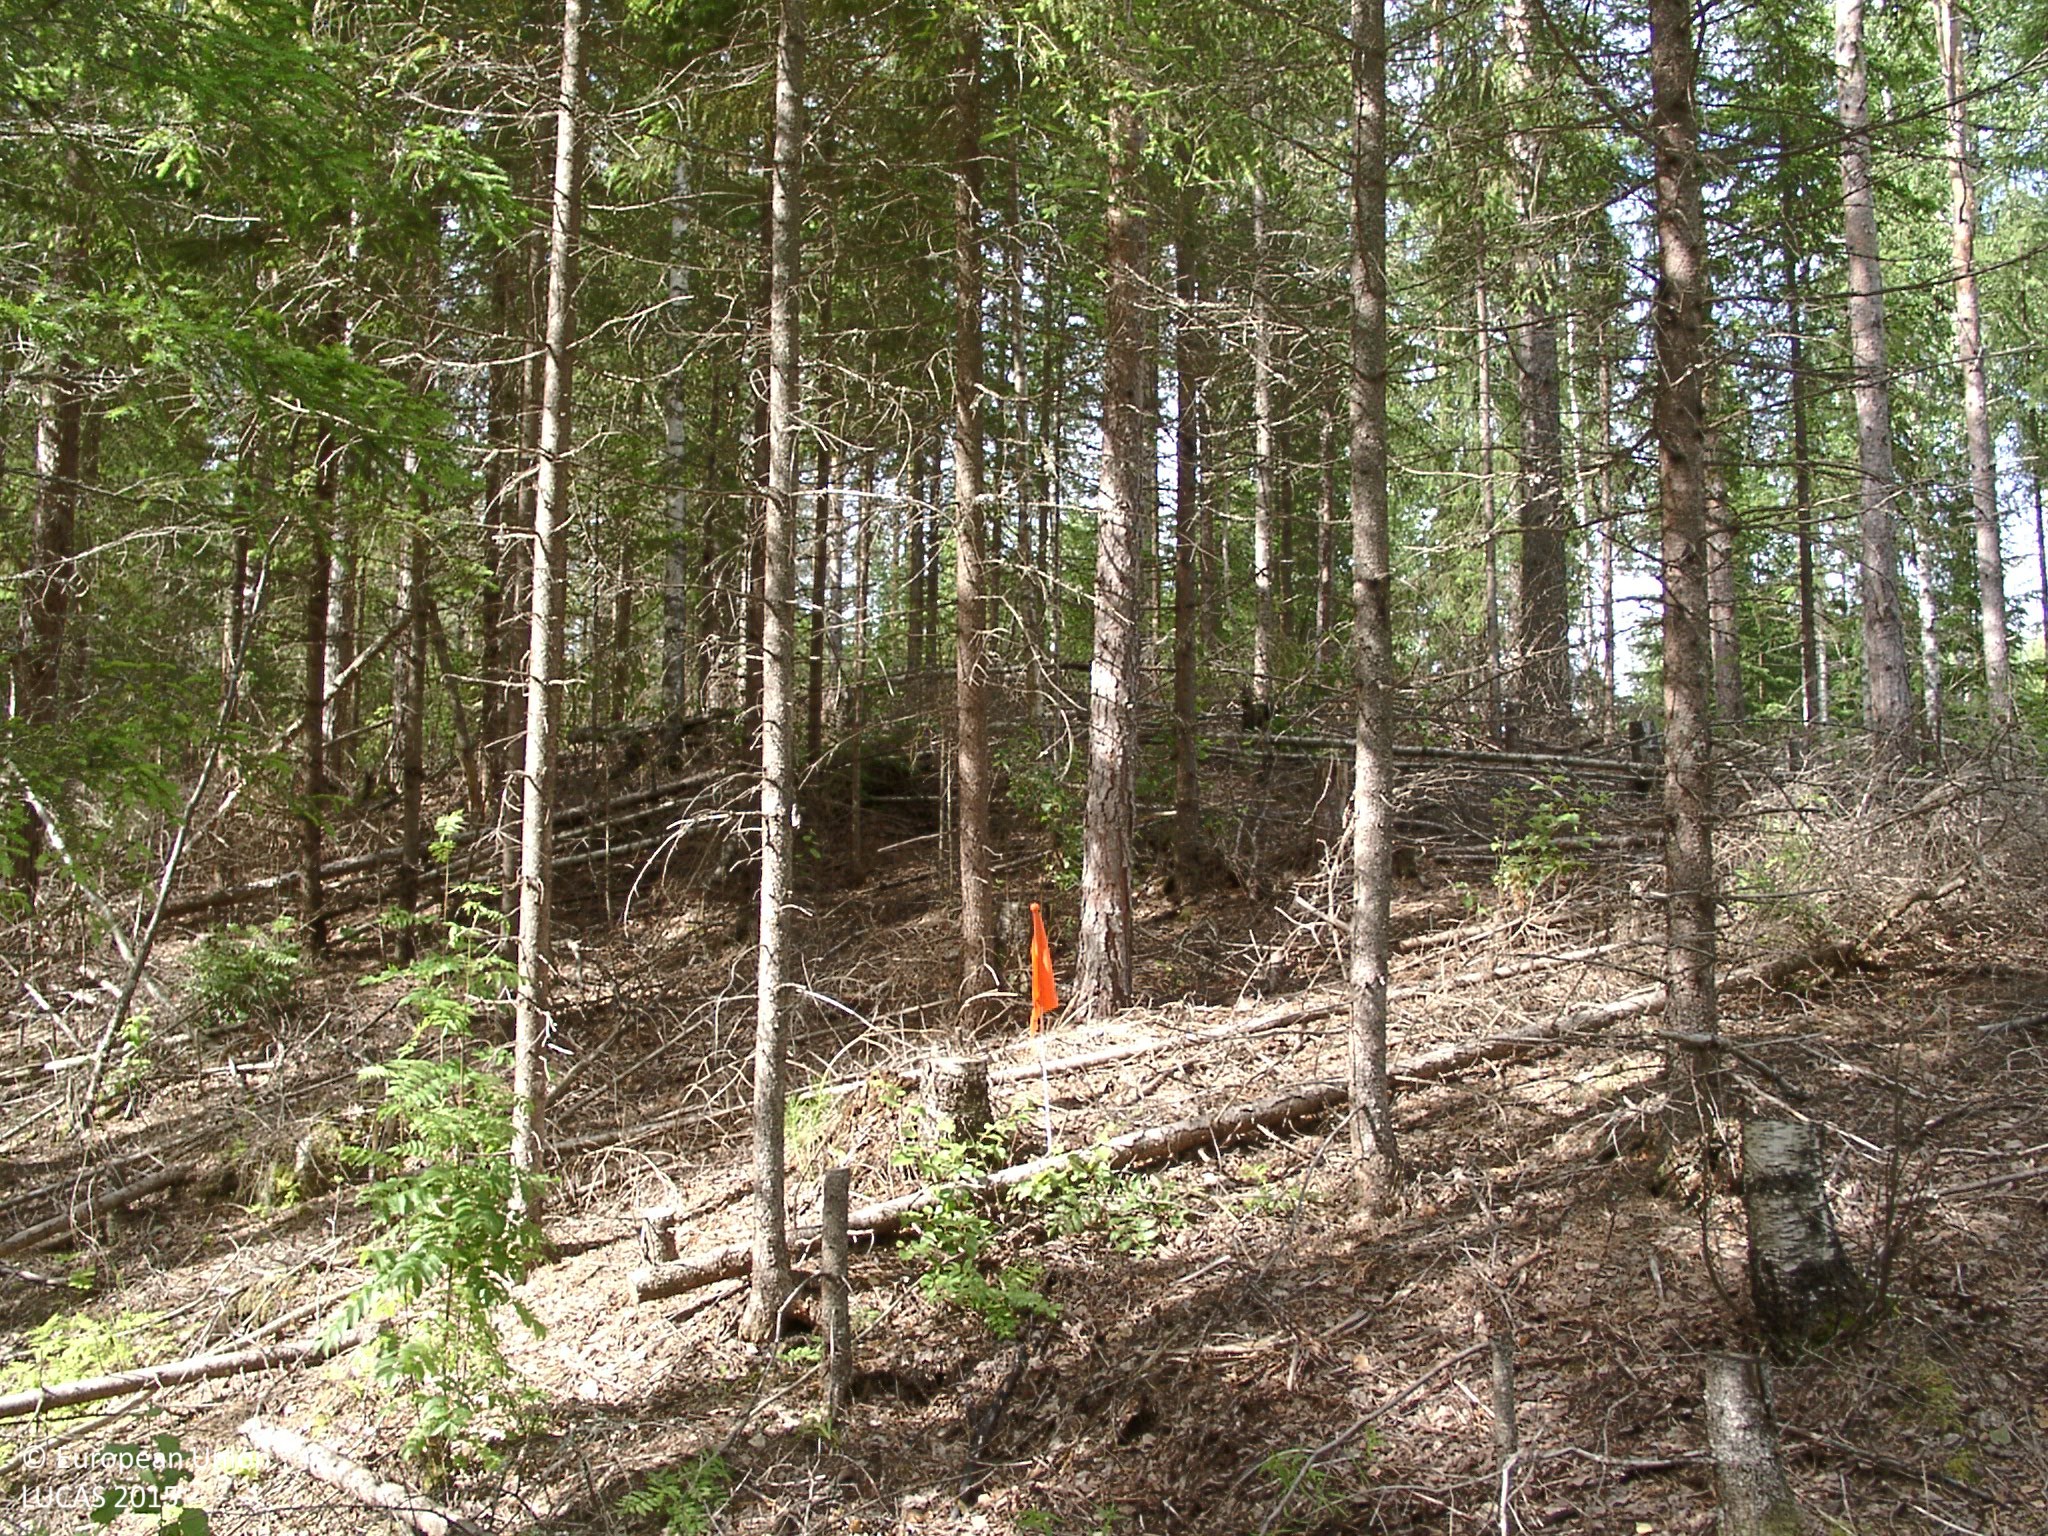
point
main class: Woodland
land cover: Other coniferous woodland
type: boreal forest
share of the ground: > 75 %
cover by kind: coniferous forest trees 70 %, broadleaved forest trees 5 %, unconsolidated bare surface 5 %
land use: Forestry
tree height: > 5 m
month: July
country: FI
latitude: 62.2106
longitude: 25.1217
